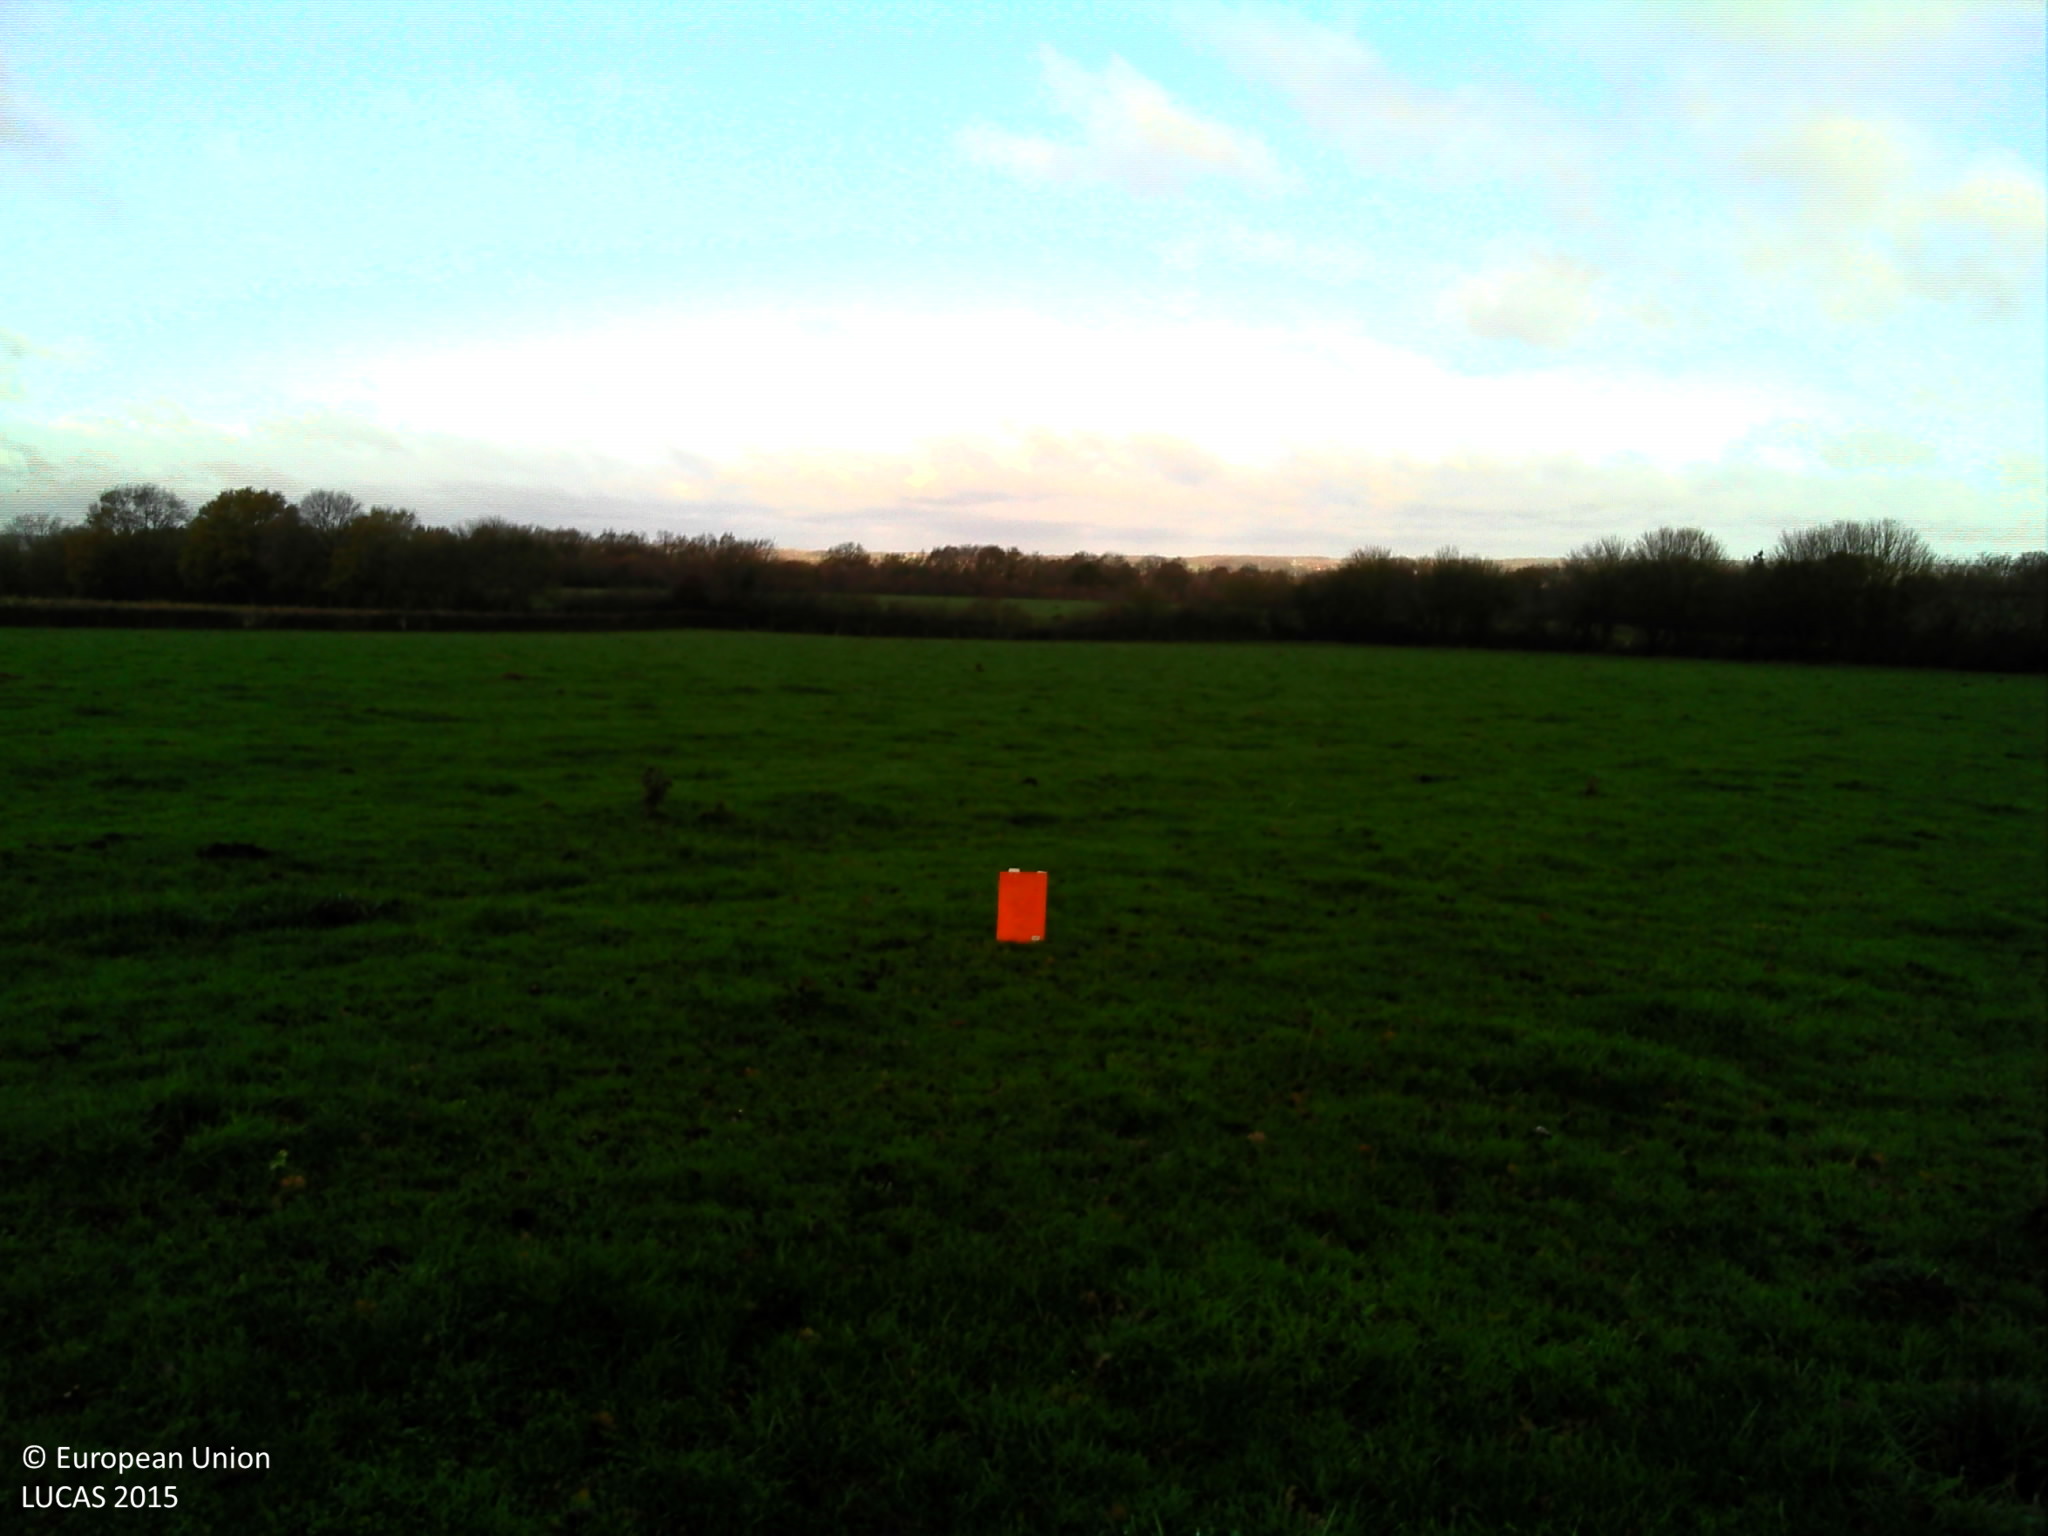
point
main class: Grassland
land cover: Grassland without tree/shrub cover
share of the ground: > 75 %
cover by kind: herbaceous plants 100 %
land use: Agriculture (excluding fallow land and kitchen gardens)
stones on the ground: < 10 %
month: August
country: FR
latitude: 46.4521
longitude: 3.6593
